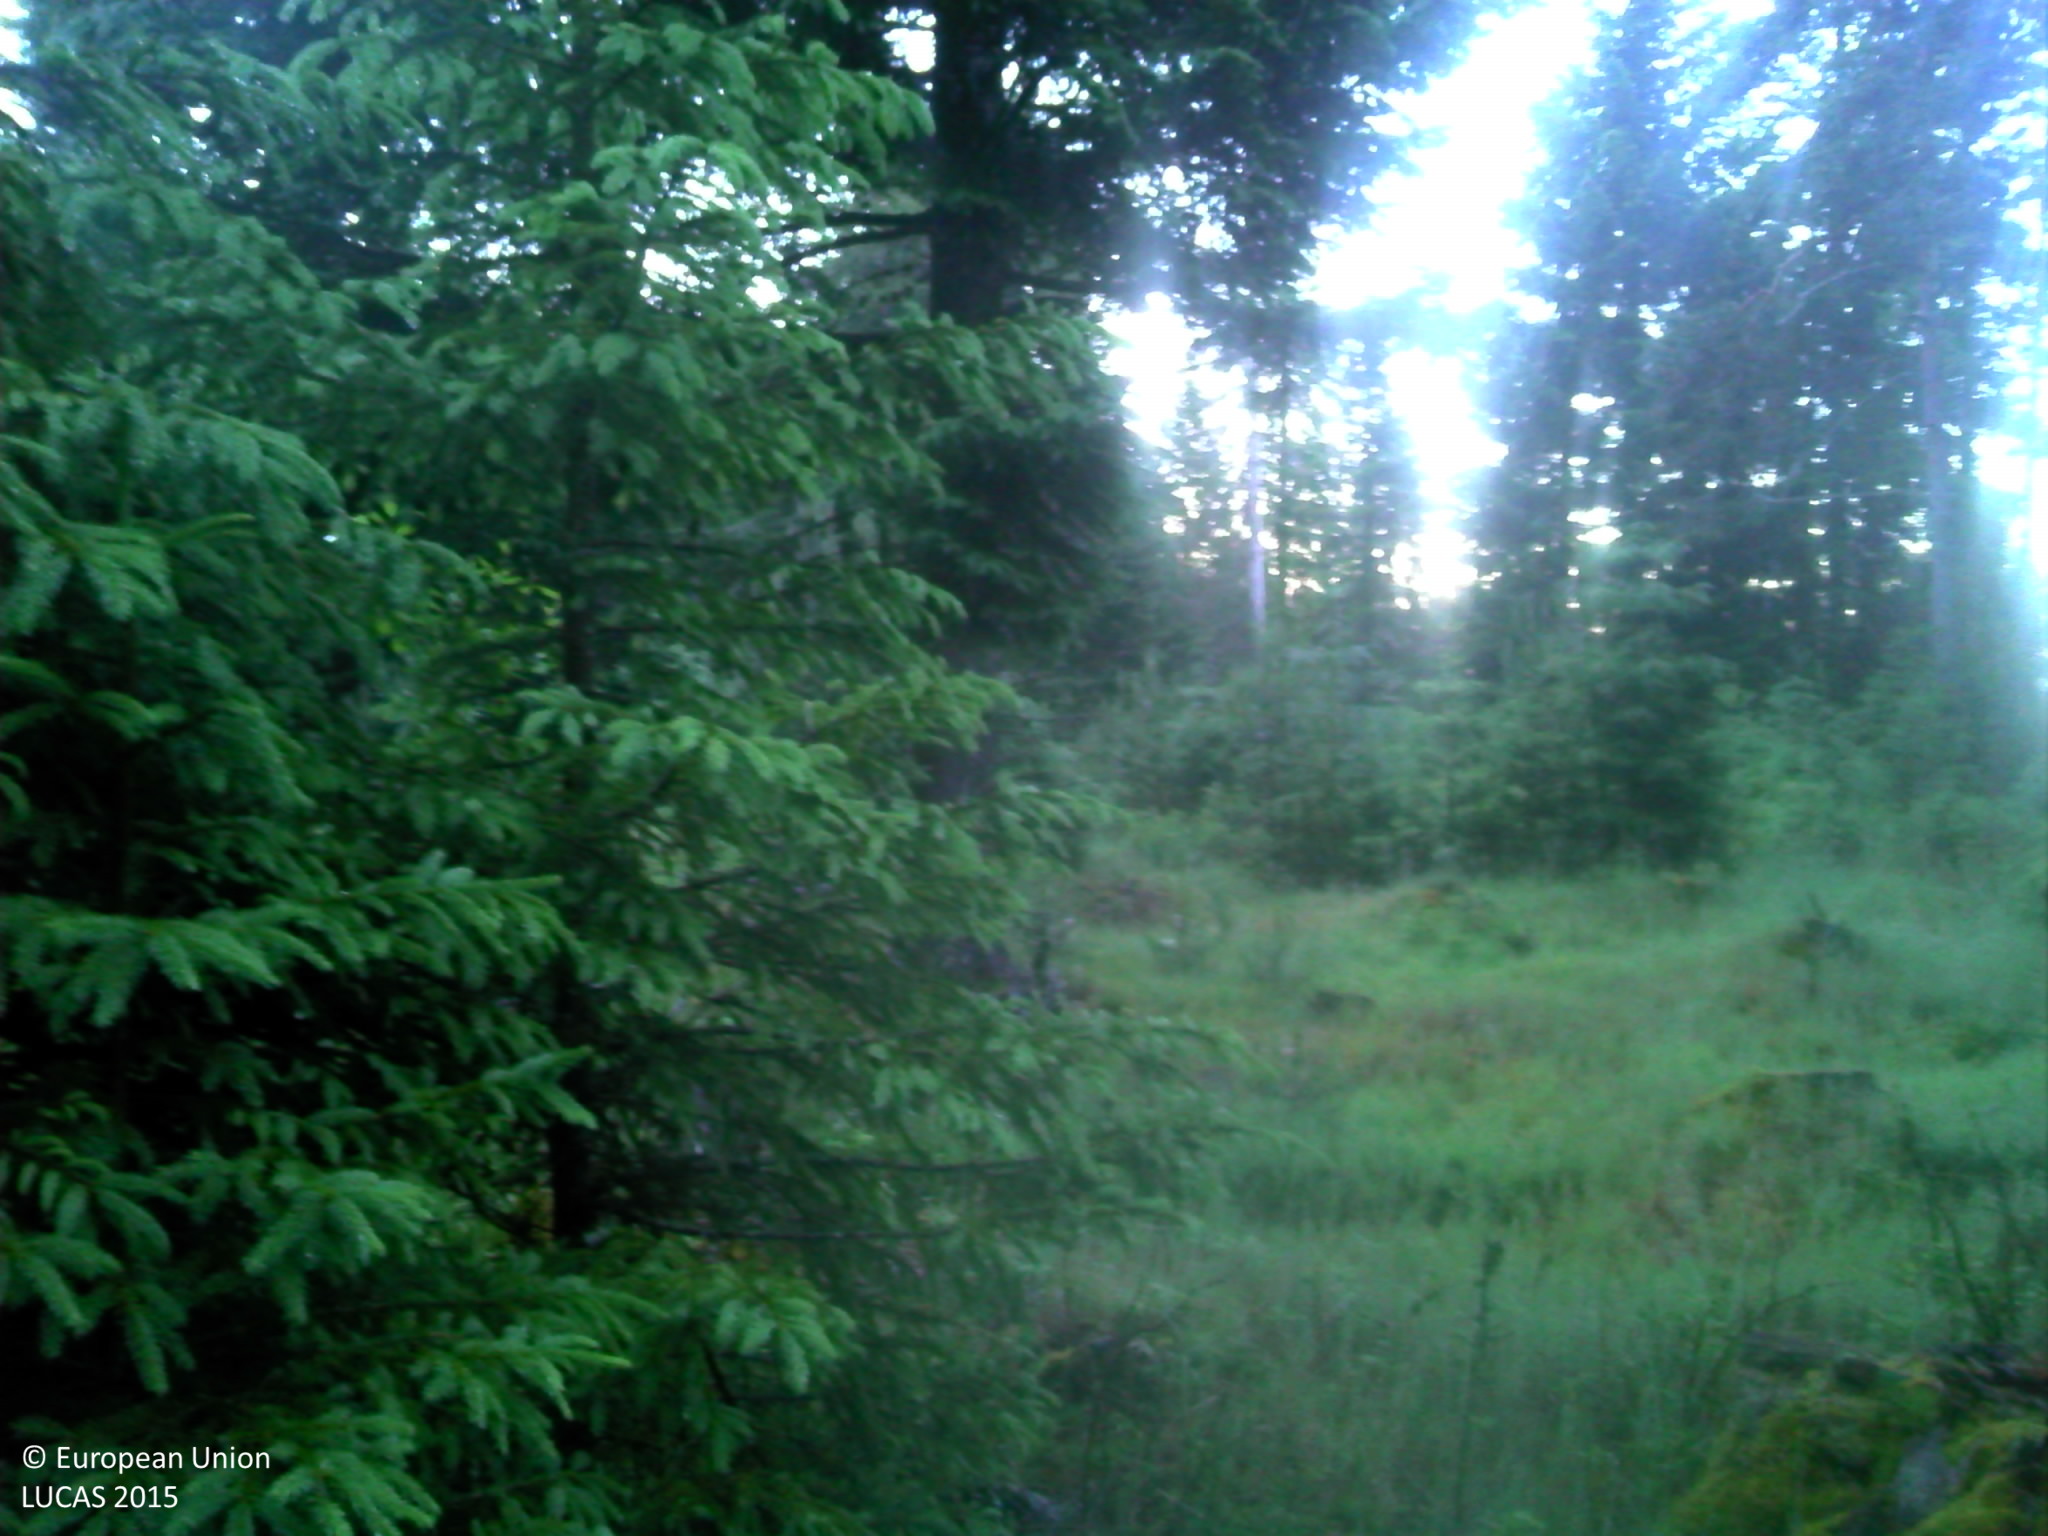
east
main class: Woodland
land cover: Spruce dominated coniferous woodland
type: alpine coniferous forest
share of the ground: > 75 %
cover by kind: coniferous forest trees 50 %, herbaceous plants 40 %, shrubs 5 %, lichens and mosses 5 %
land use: Forestry
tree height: > 5 m
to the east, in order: Spruce dominated coniferous woodland; Spruce dominated mixed woodland; Pine dominated coniferous woodland
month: June
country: FR
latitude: 45.1919
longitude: 2.8859
